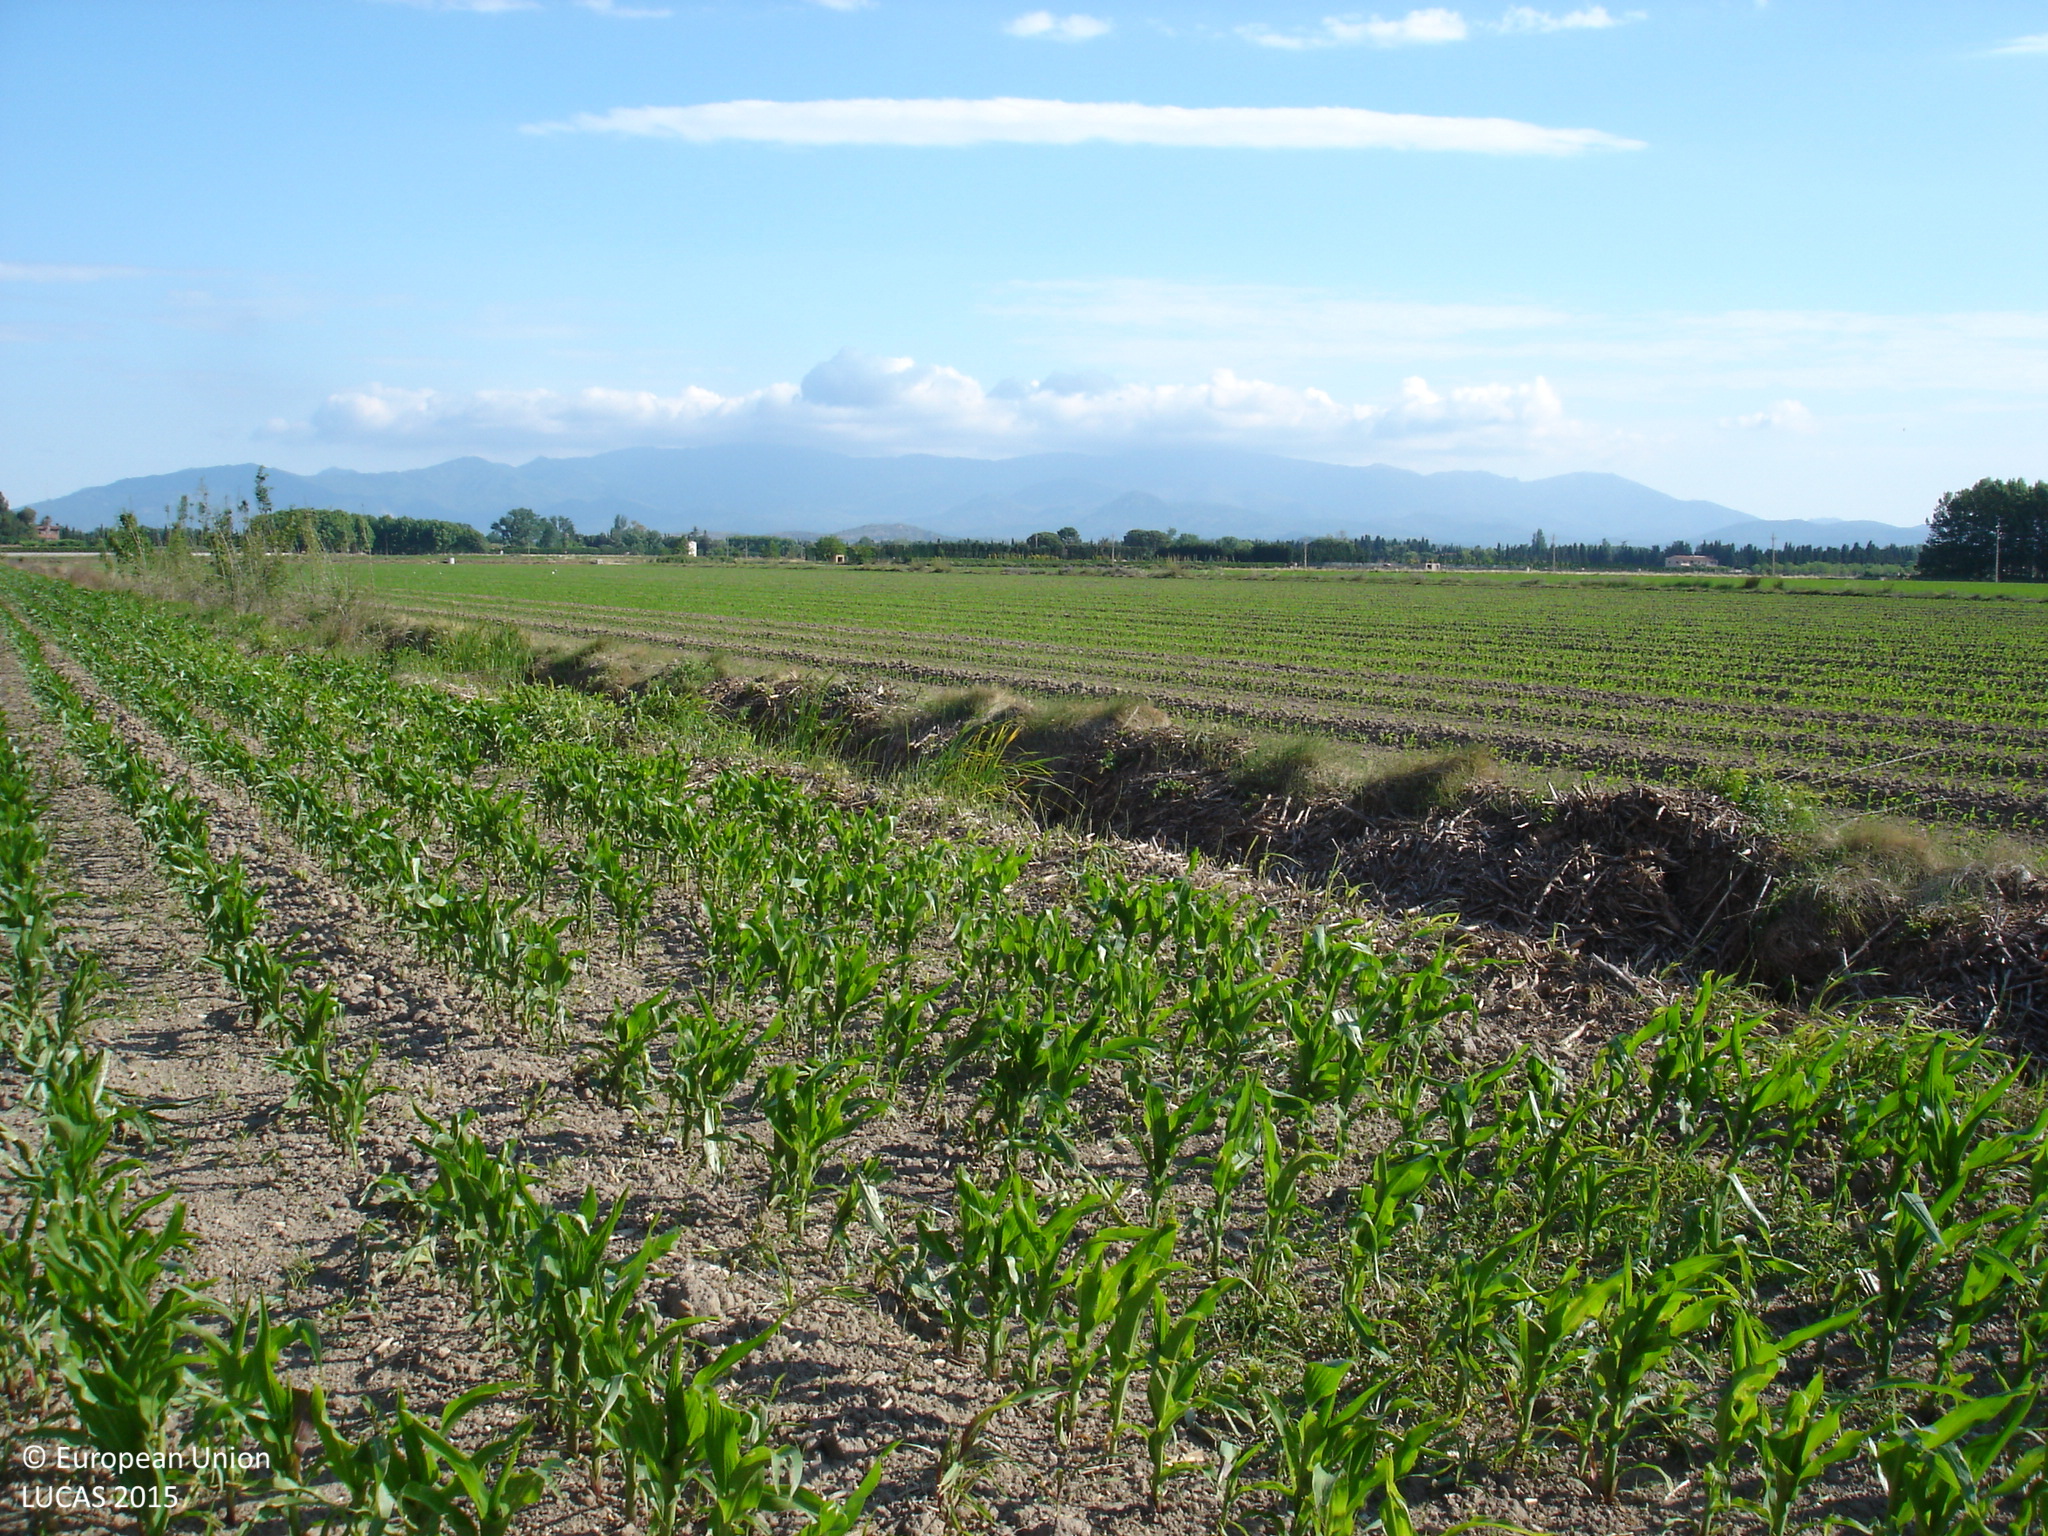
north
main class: Cropland
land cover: Maize
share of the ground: 25 - 50 %
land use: Agriculture (excluding fallow land and kitchen gardens)
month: May
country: ES
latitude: 42.2826
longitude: 2.9686
